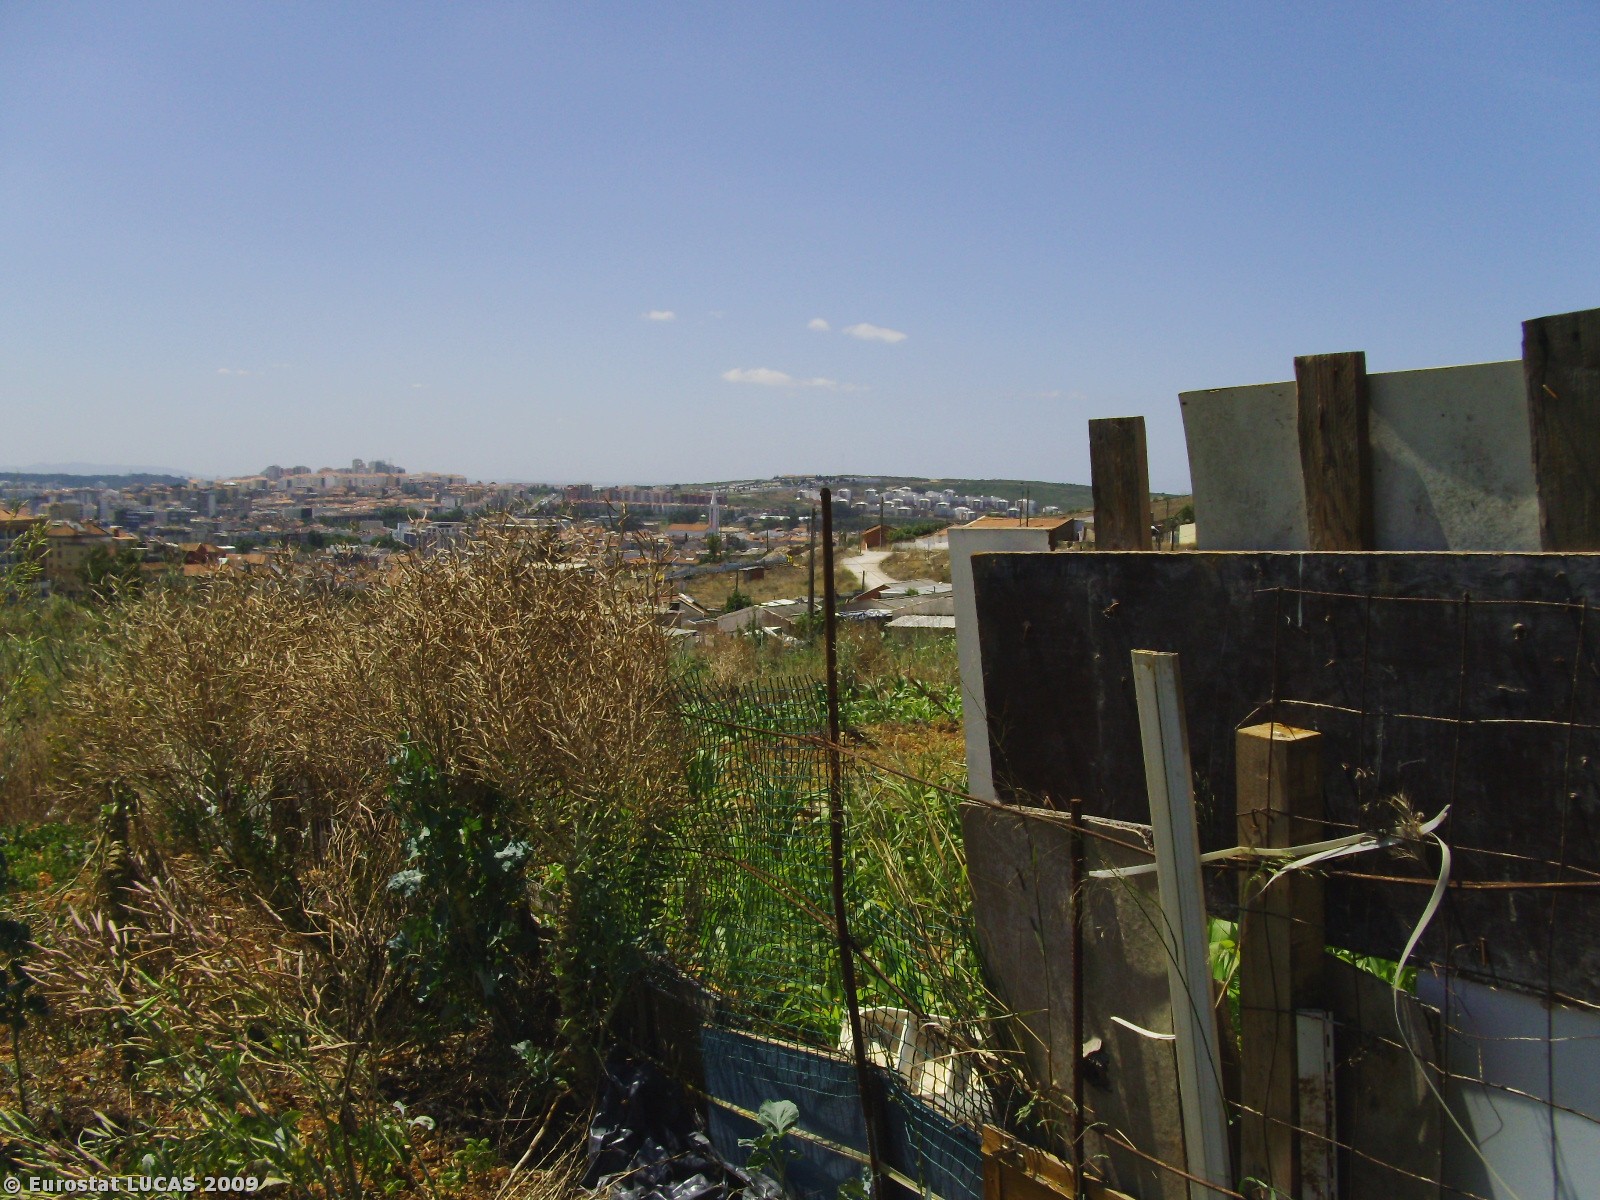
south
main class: Cropland
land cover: Dry pulses
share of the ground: 50 - 75 %
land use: Kitchen garden
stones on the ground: > 50 %
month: July
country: PT
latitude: 38.7685
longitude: -9.2421
